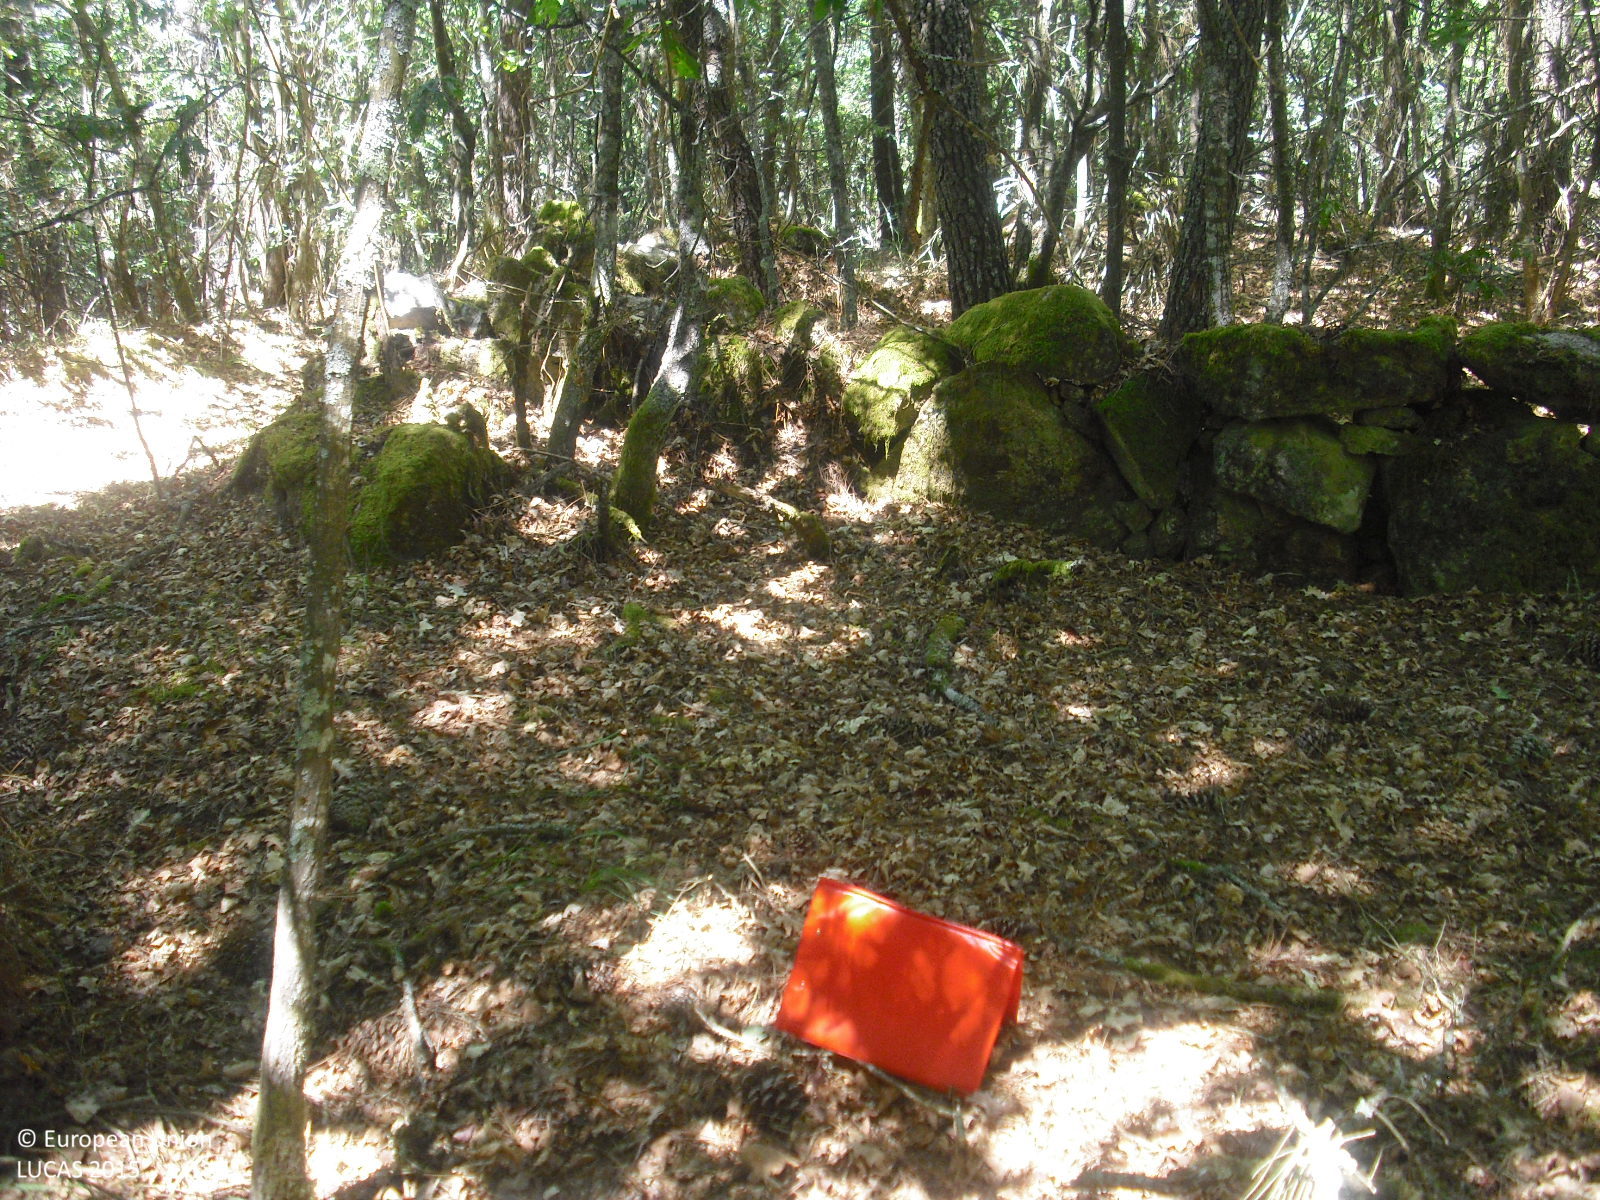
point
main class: Woodland
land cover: Pine dominated mixed woodland
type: hemiboreal forest and nemoral coniferous forest and mixed broadleaved-coniferous forest
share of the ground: > 75 %
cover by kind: broadleaved forest trees 60 %, coniferous forest trees 40 %
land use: Forestry
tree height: > 5 m
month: June
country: ES
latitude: 42.4867
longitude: -7.7781
